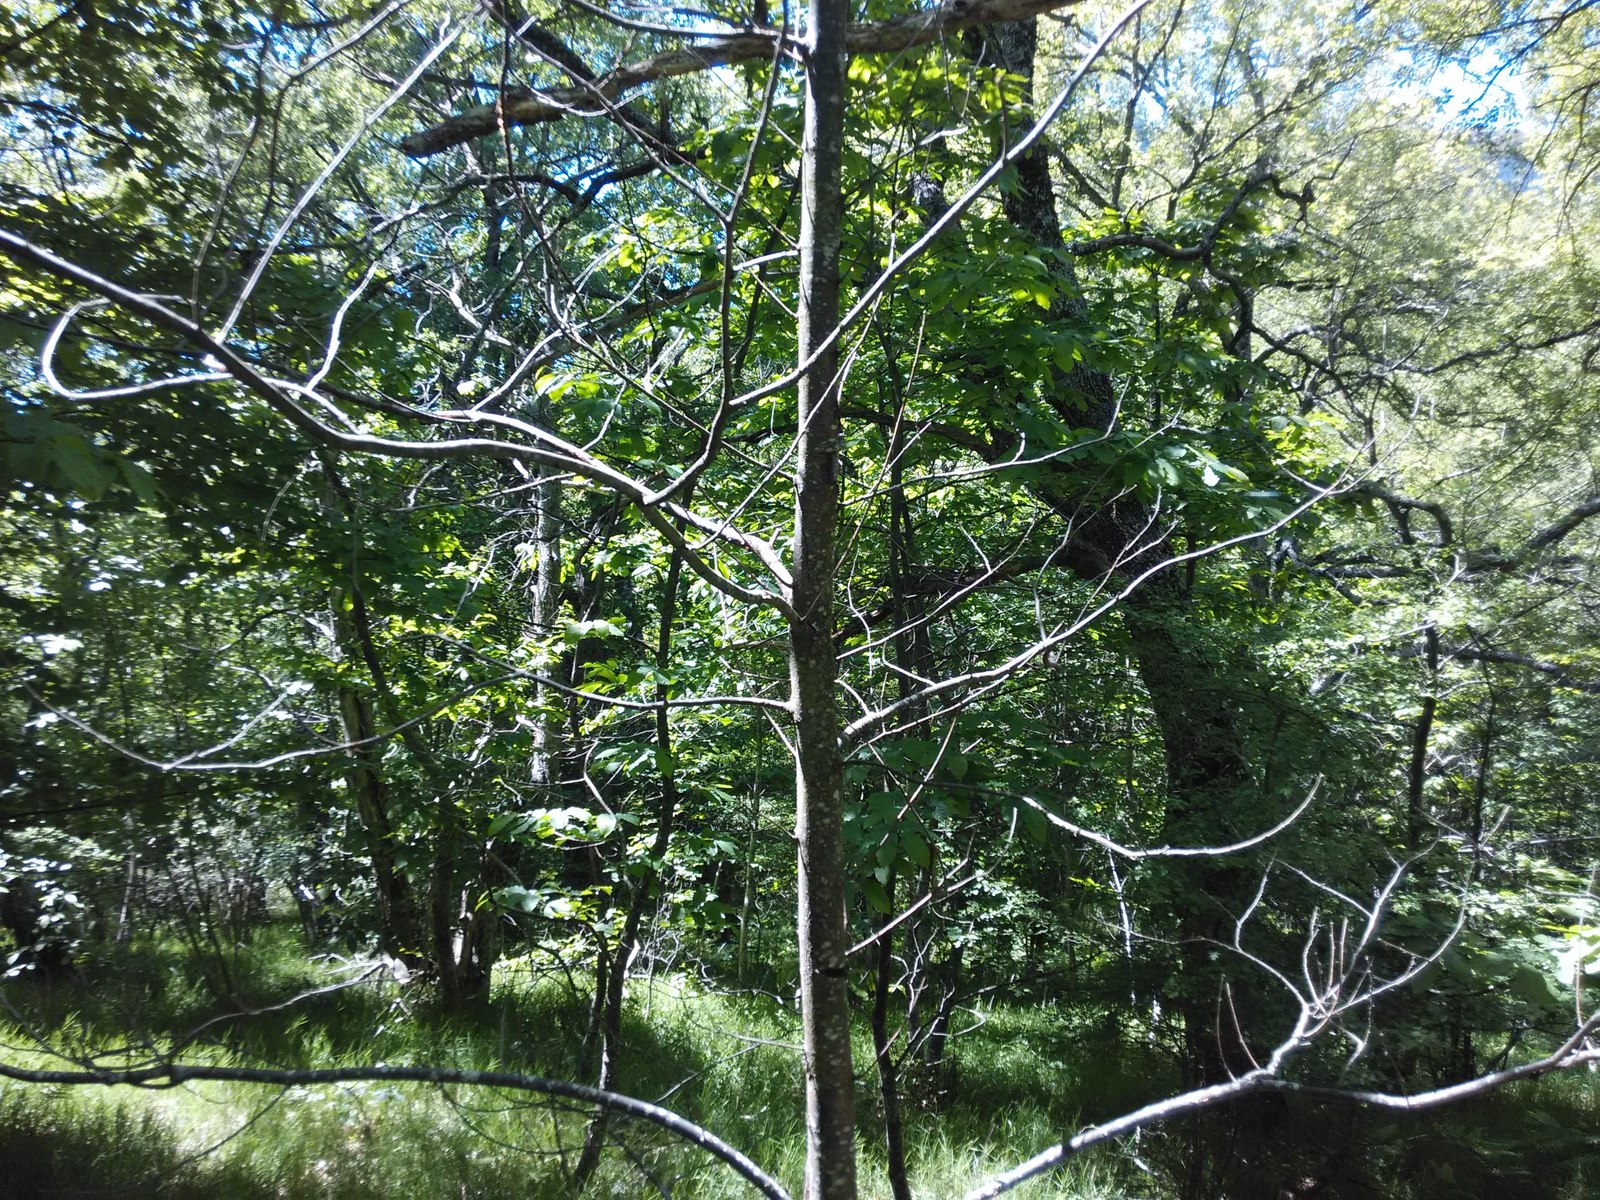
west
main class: Woodland
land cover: Broadleaved woodland
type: acidophilous oak and oak-birch forest
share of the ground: > 75 %
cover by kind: broadleaved forest trees 80 %, shrubs 10 %, herbaceous plants 10 %
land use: Forestry
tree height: > 5 m
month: May
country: ES
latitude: 42.6904
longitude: -2.4108
